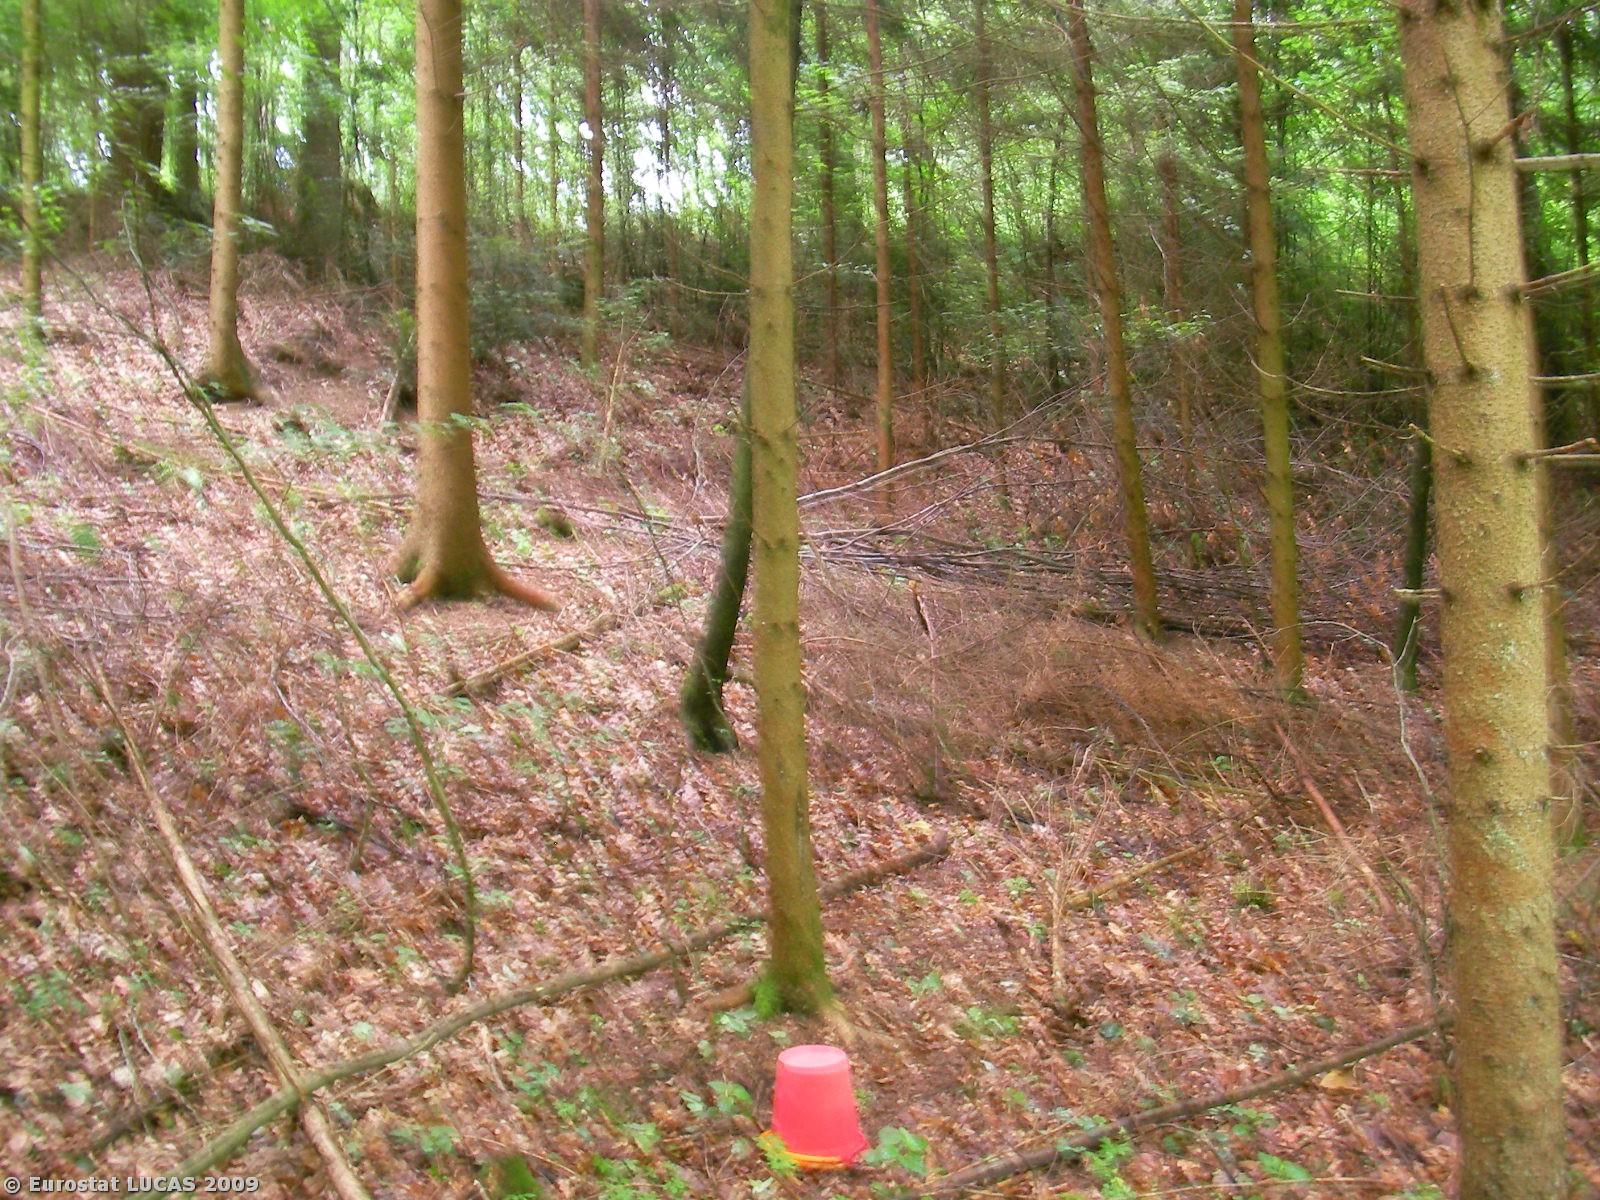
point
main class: Woodland
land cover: Mixed woodland
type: hemiboreal forest and nemoral coniferous forest and mixed broadleaved-coniferous forest
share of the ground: > 75 %
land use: Forestry
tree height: > 5 m
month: June
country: AT
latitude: 47.1360
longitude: 15.7360
